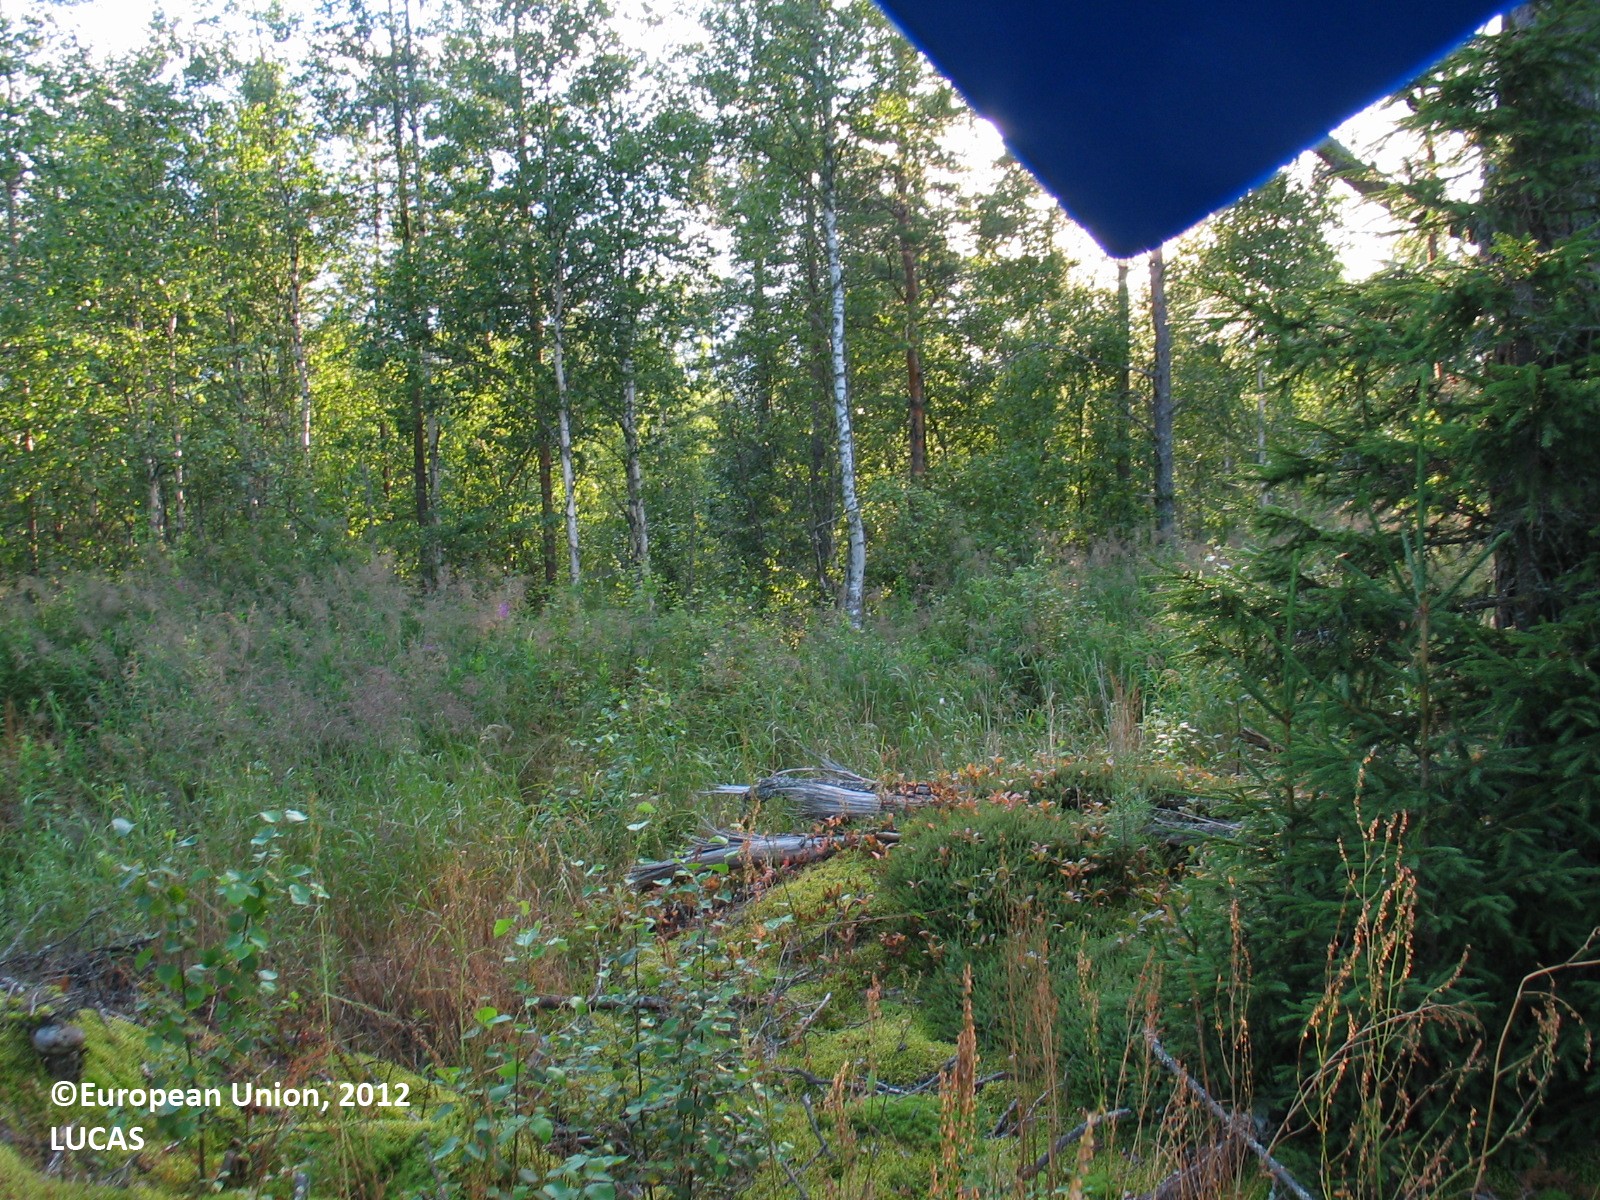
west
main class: Woodland
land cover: Other mixed woodland
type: boreal forest
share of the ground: 25 - 50 %
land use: Forestry
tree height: > 5 m
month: July
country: FI
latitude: 64.7034
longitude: 26.4067
